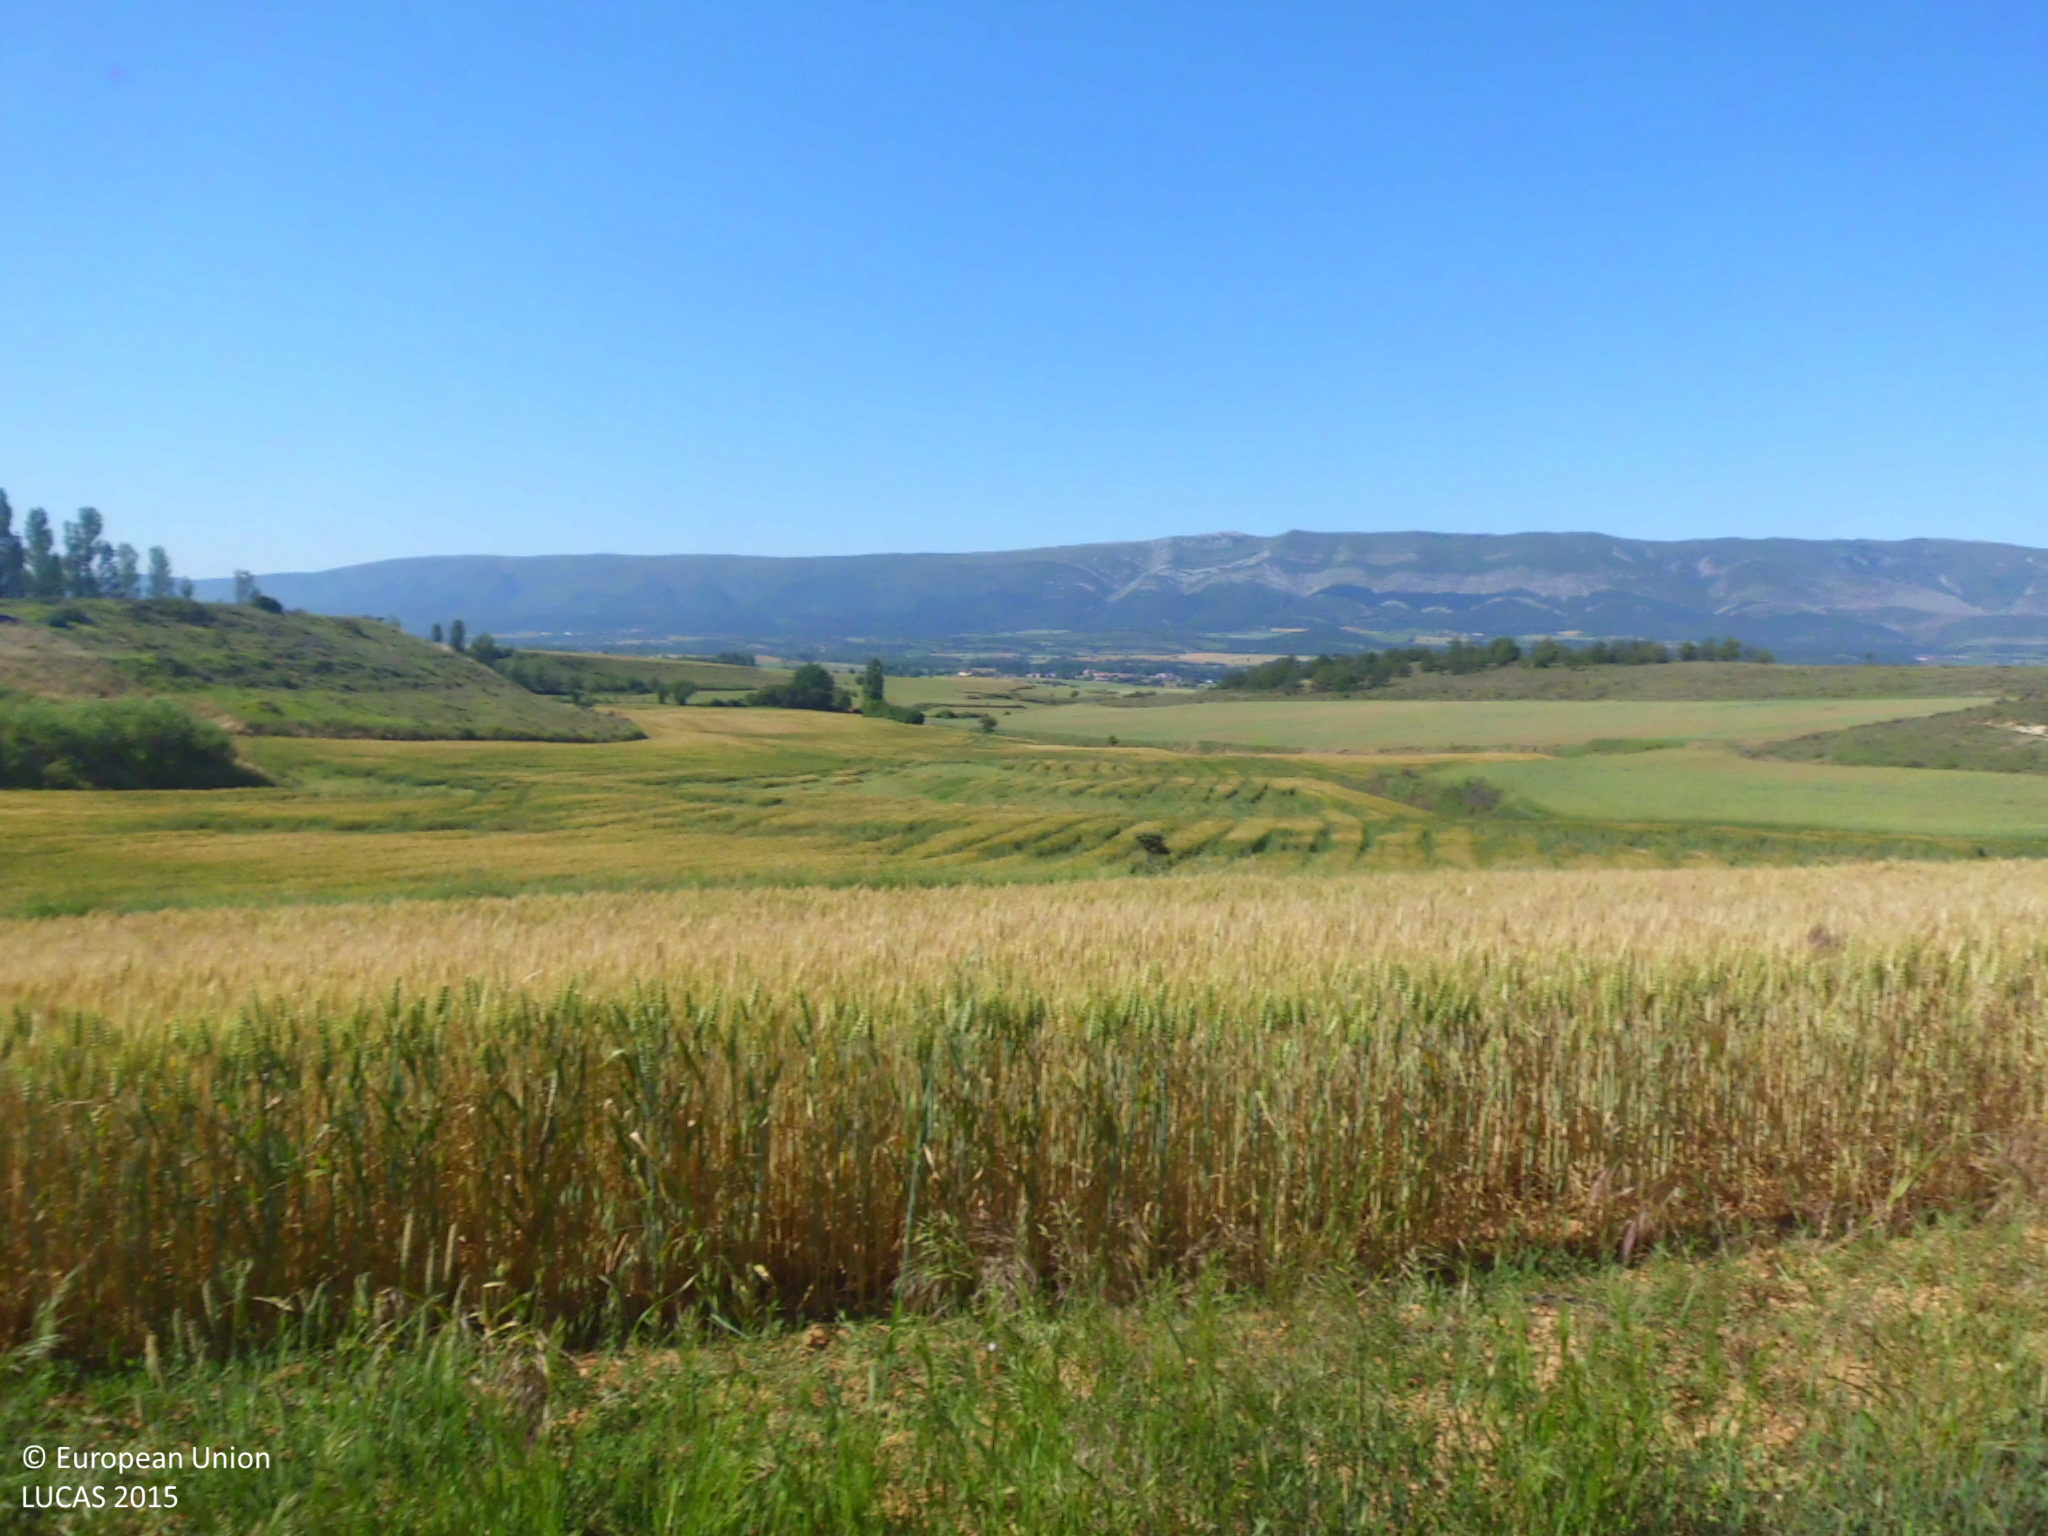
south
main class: Shrubland
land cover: Shrubland with sparse tree cover
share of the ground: 25 - 50 %
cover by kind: herbaceous plants 55 %, shrubs 30 %, consolidated bare surface 10 %, coniferous forest trees 5 %
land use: Semi-natural and natural areas not in use
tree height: < 5 m
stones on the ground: 10 - 25 %
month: June
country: ES
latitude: 42.9218
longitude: -3.4535
